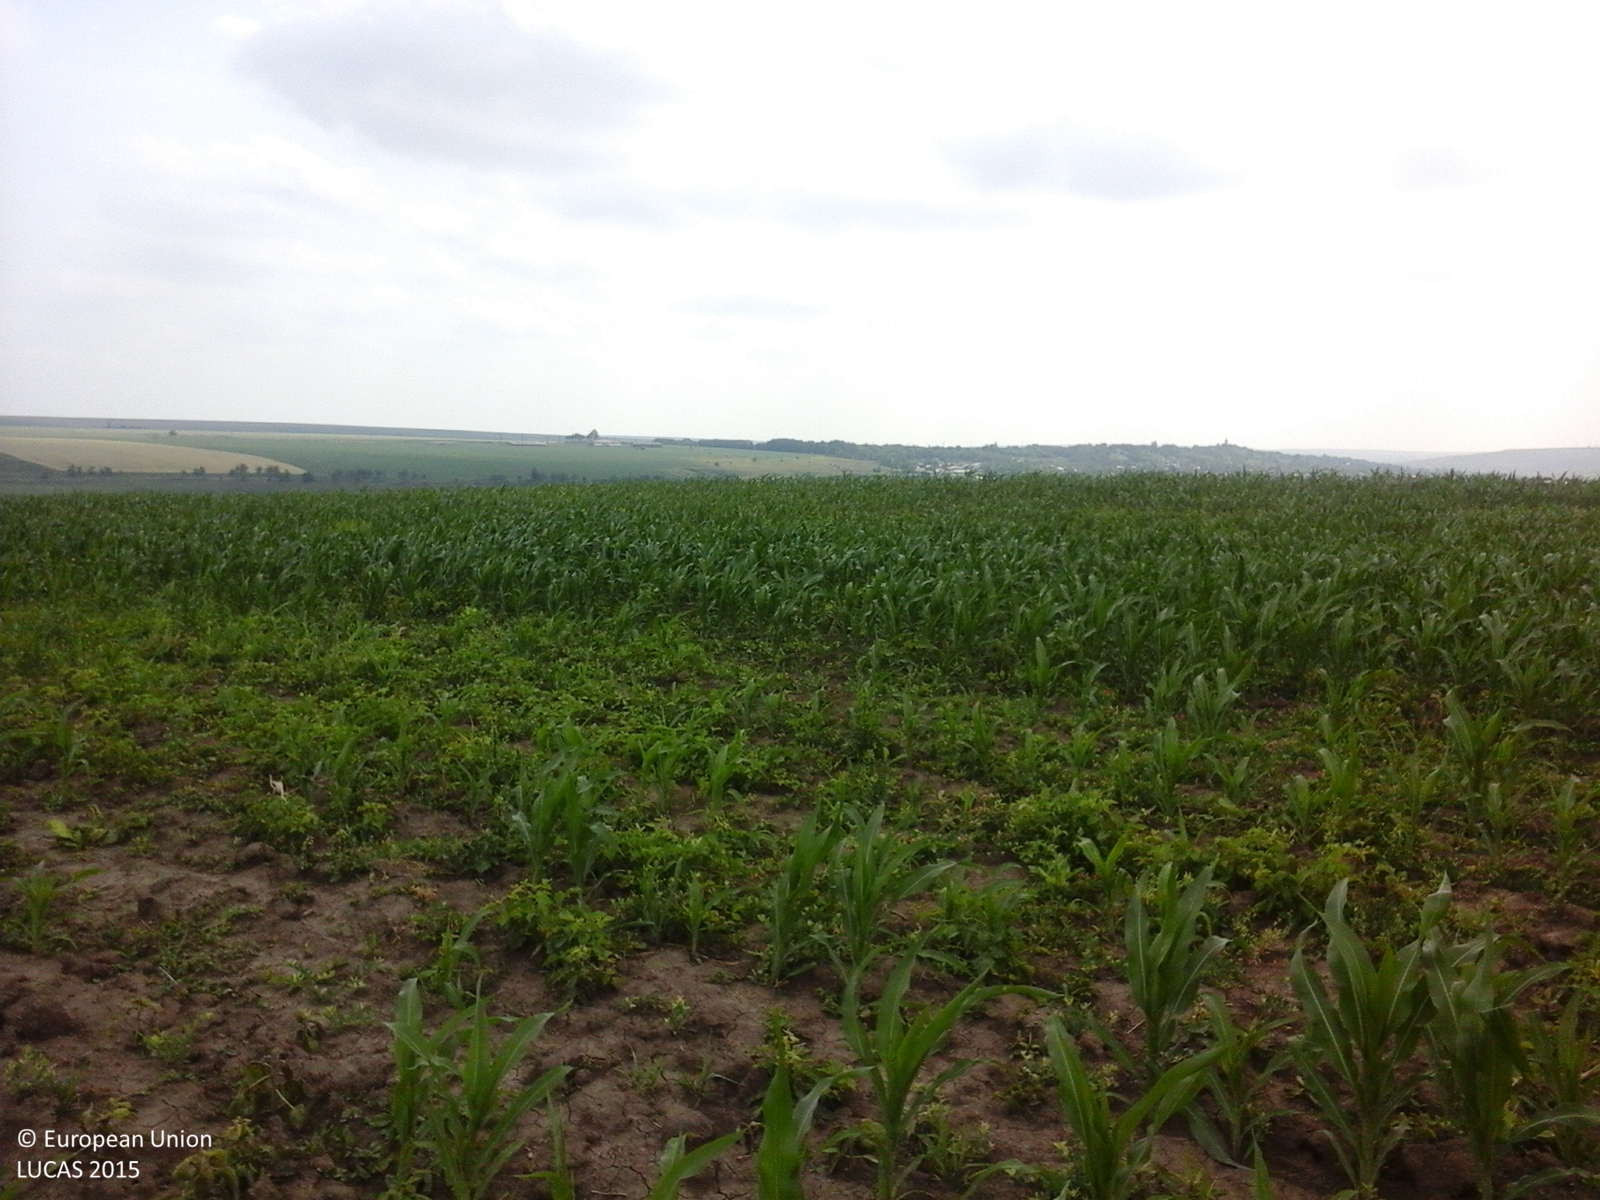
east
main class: Cropland
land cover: Maize
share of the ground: 25 - 50 %
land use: Agriculture (excluding fallow land and kitchen gardens)
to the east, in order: Maize; Sunflower; Lucerne; Maize
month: June
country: RO
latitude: 47.8104
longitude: 26.6403
